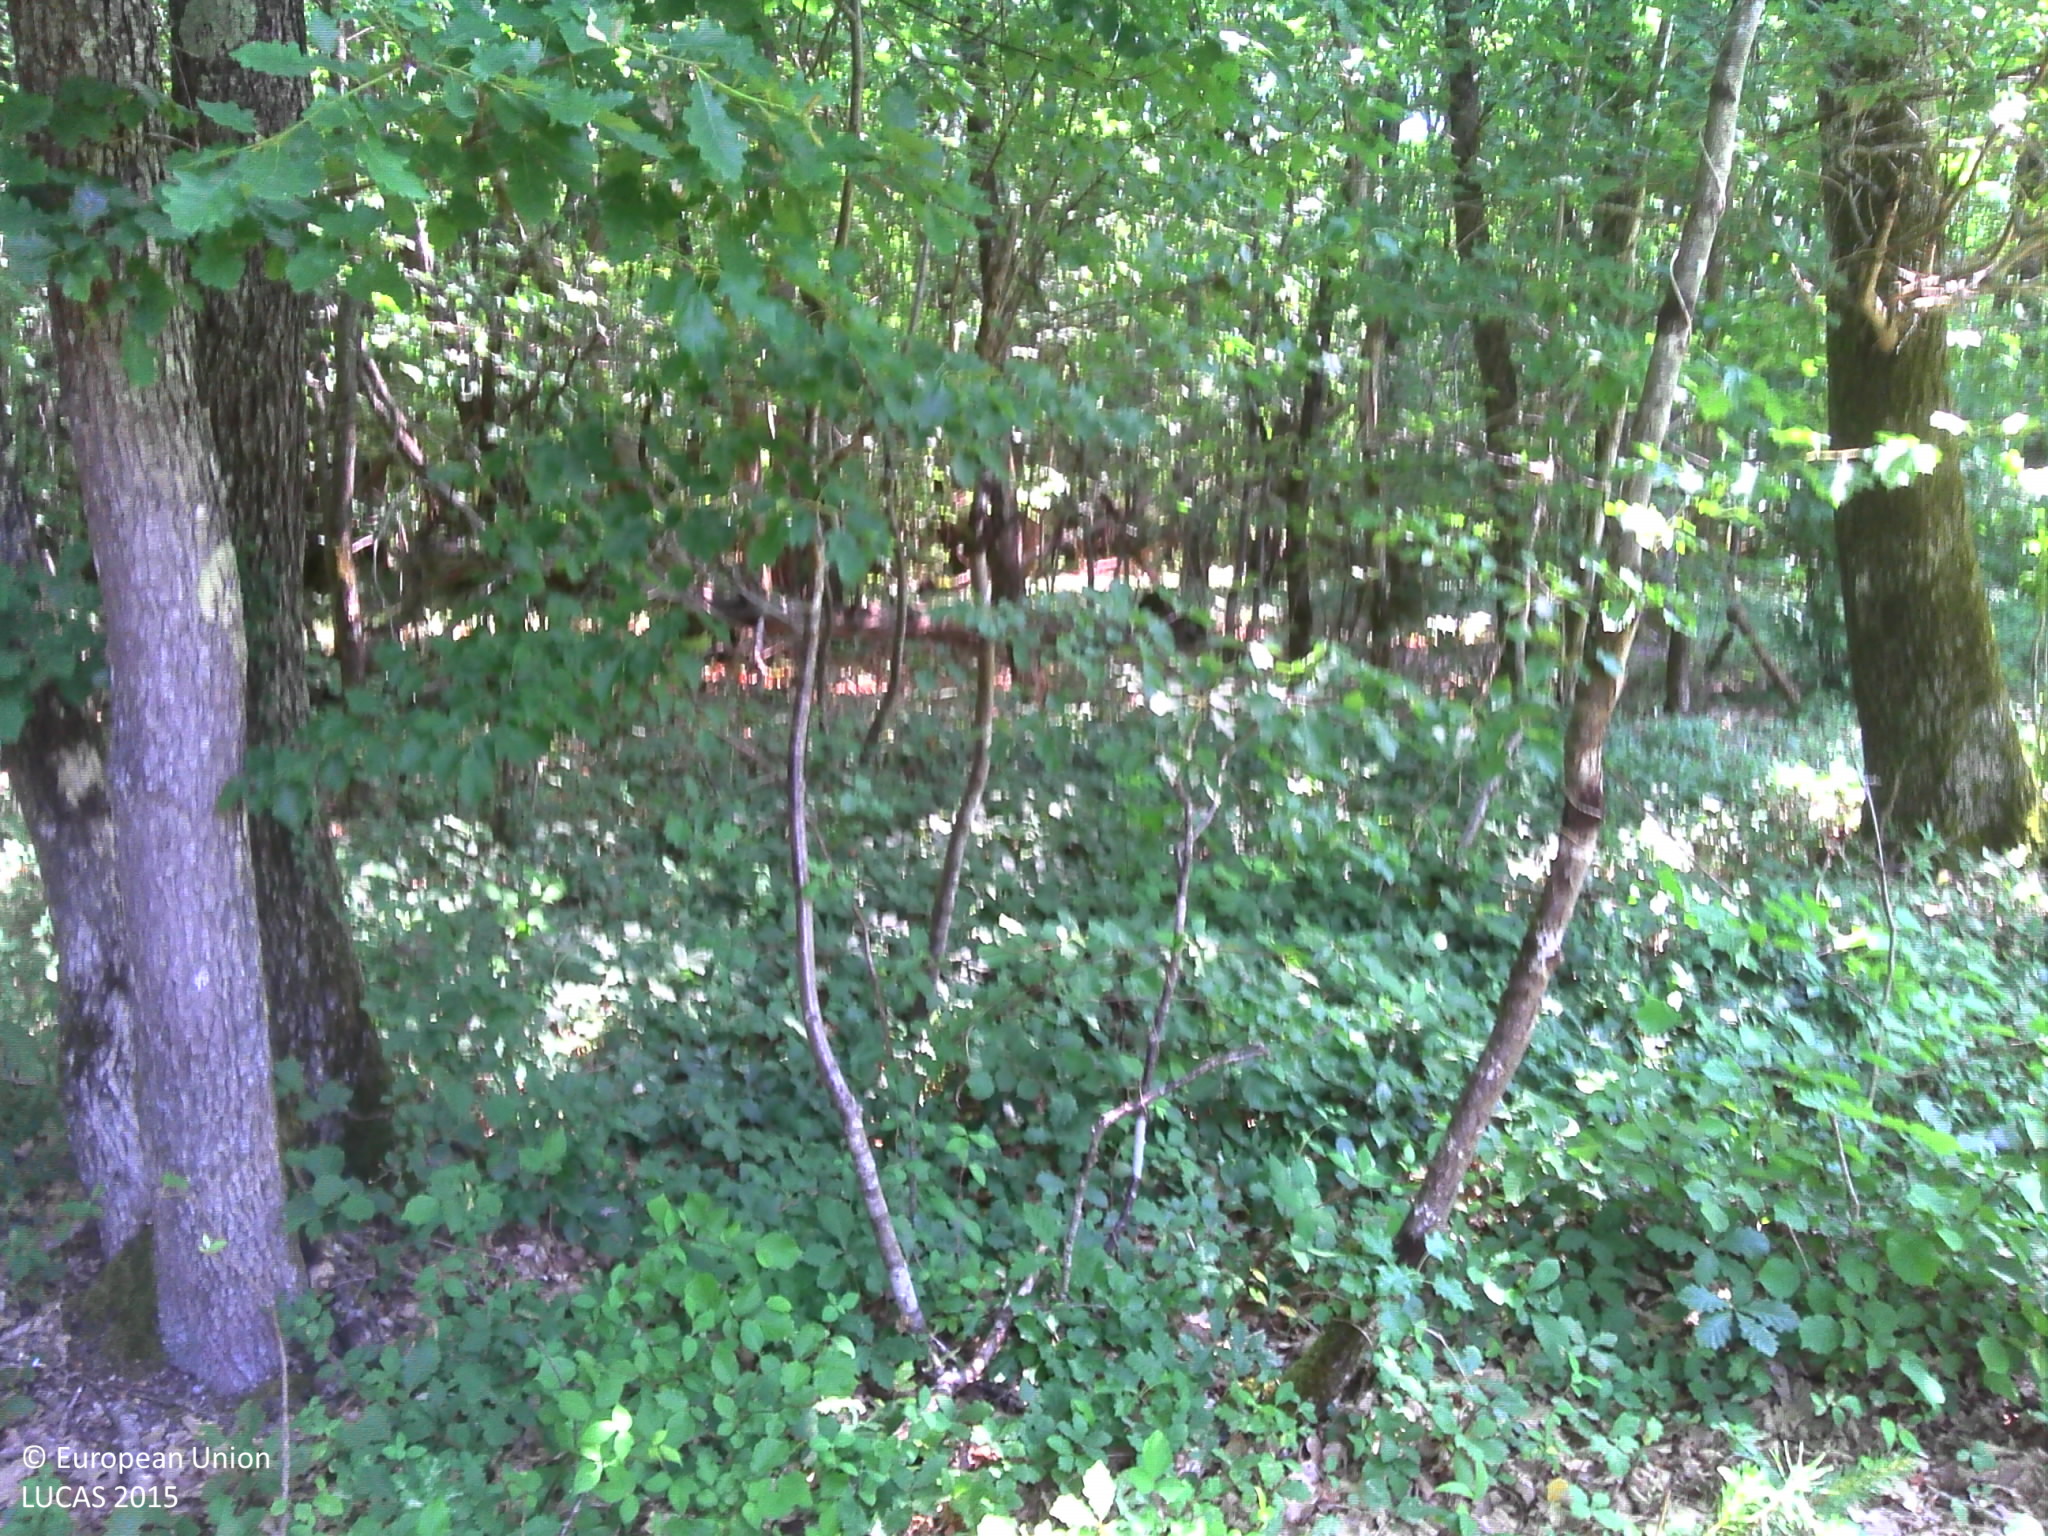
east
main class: Woodland
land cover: Broadleaved woodland
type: mesophytic deciduous forest
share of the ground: > 75 %
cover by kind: broadleaved forest trees 80 %, herbaceous plants 10 %, coniferous forest trees 5 %, lichens and mosses 5 %
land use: Forestry
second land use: Amenities, museums, leisure
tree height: > 5 m
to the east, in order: Broadleaved woodland; Ditches and canals; Broadleaved woodland; Ditches and canals; Broadleaved woodland
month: June
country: FR
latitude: 47.4368
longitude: 0.7657
